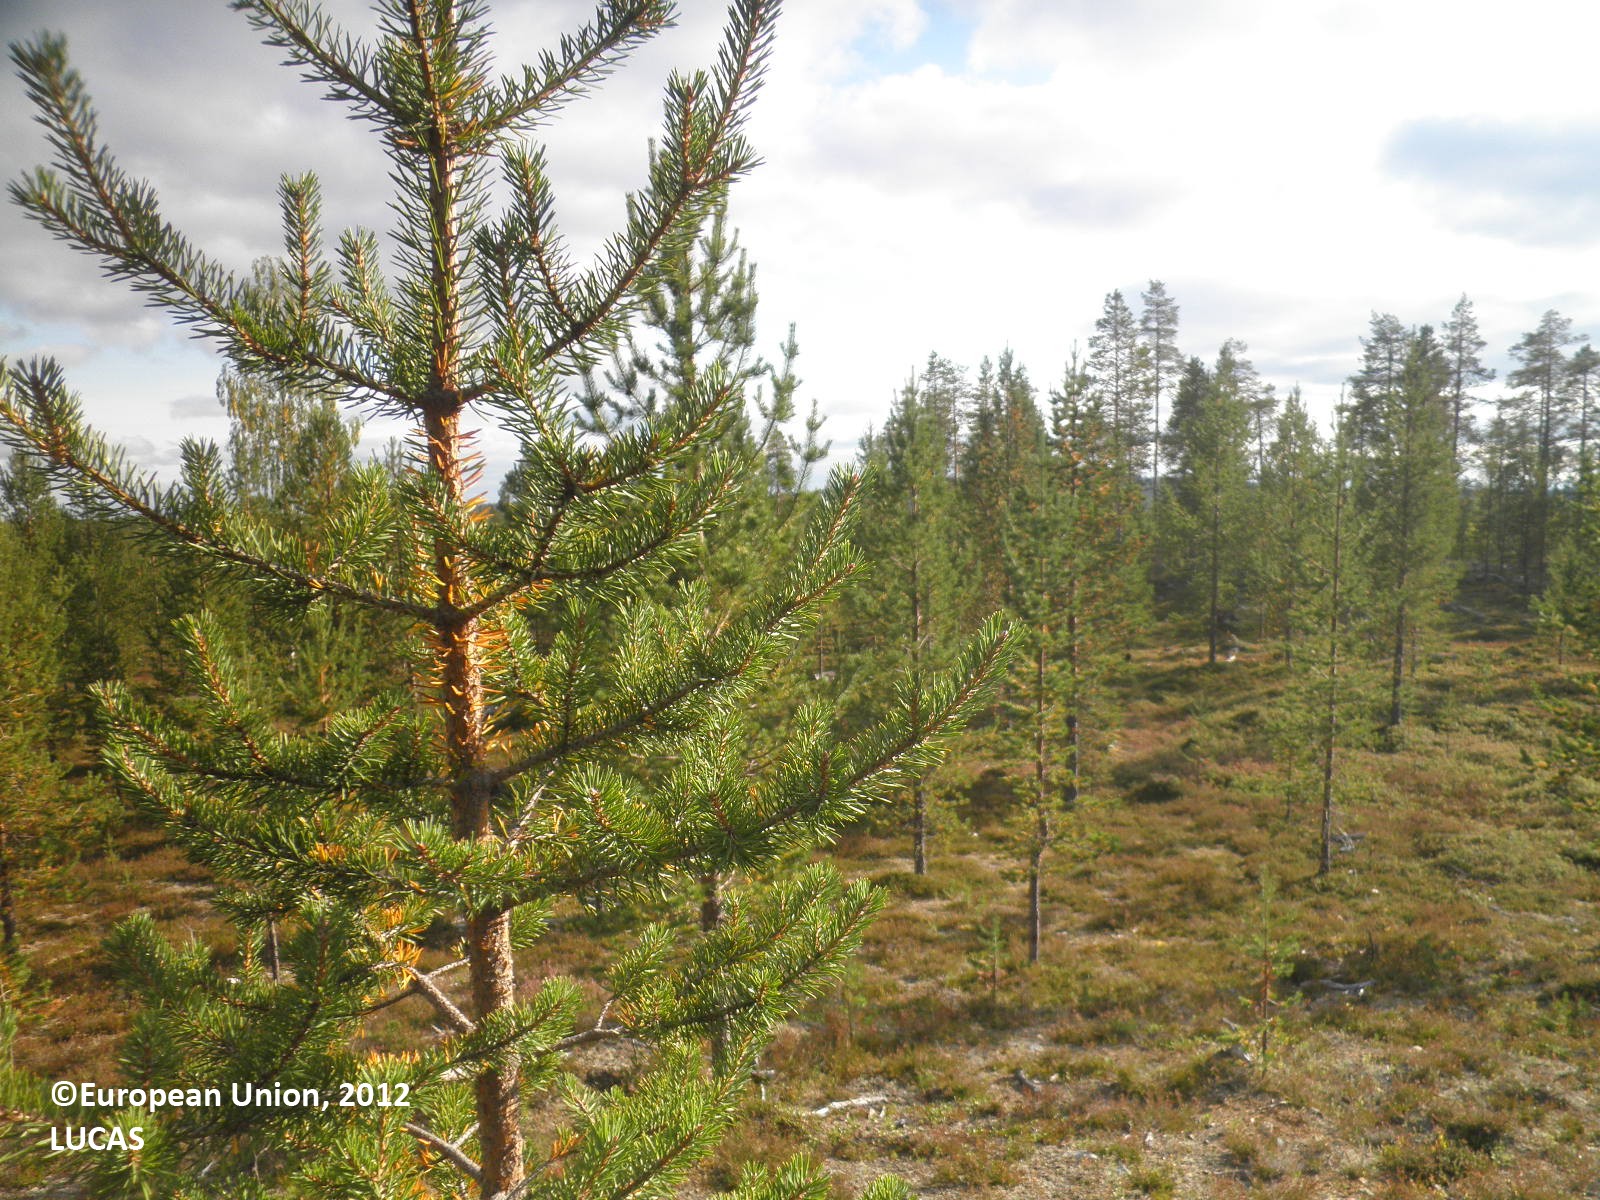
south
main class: Woodland
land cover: Pine dominated coniferous woodland
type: boreal forest
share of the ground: 10 - 25 %
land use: Forestry
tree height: > 5 m
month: August
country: FI
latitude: 67.9008
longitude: 29.0274
